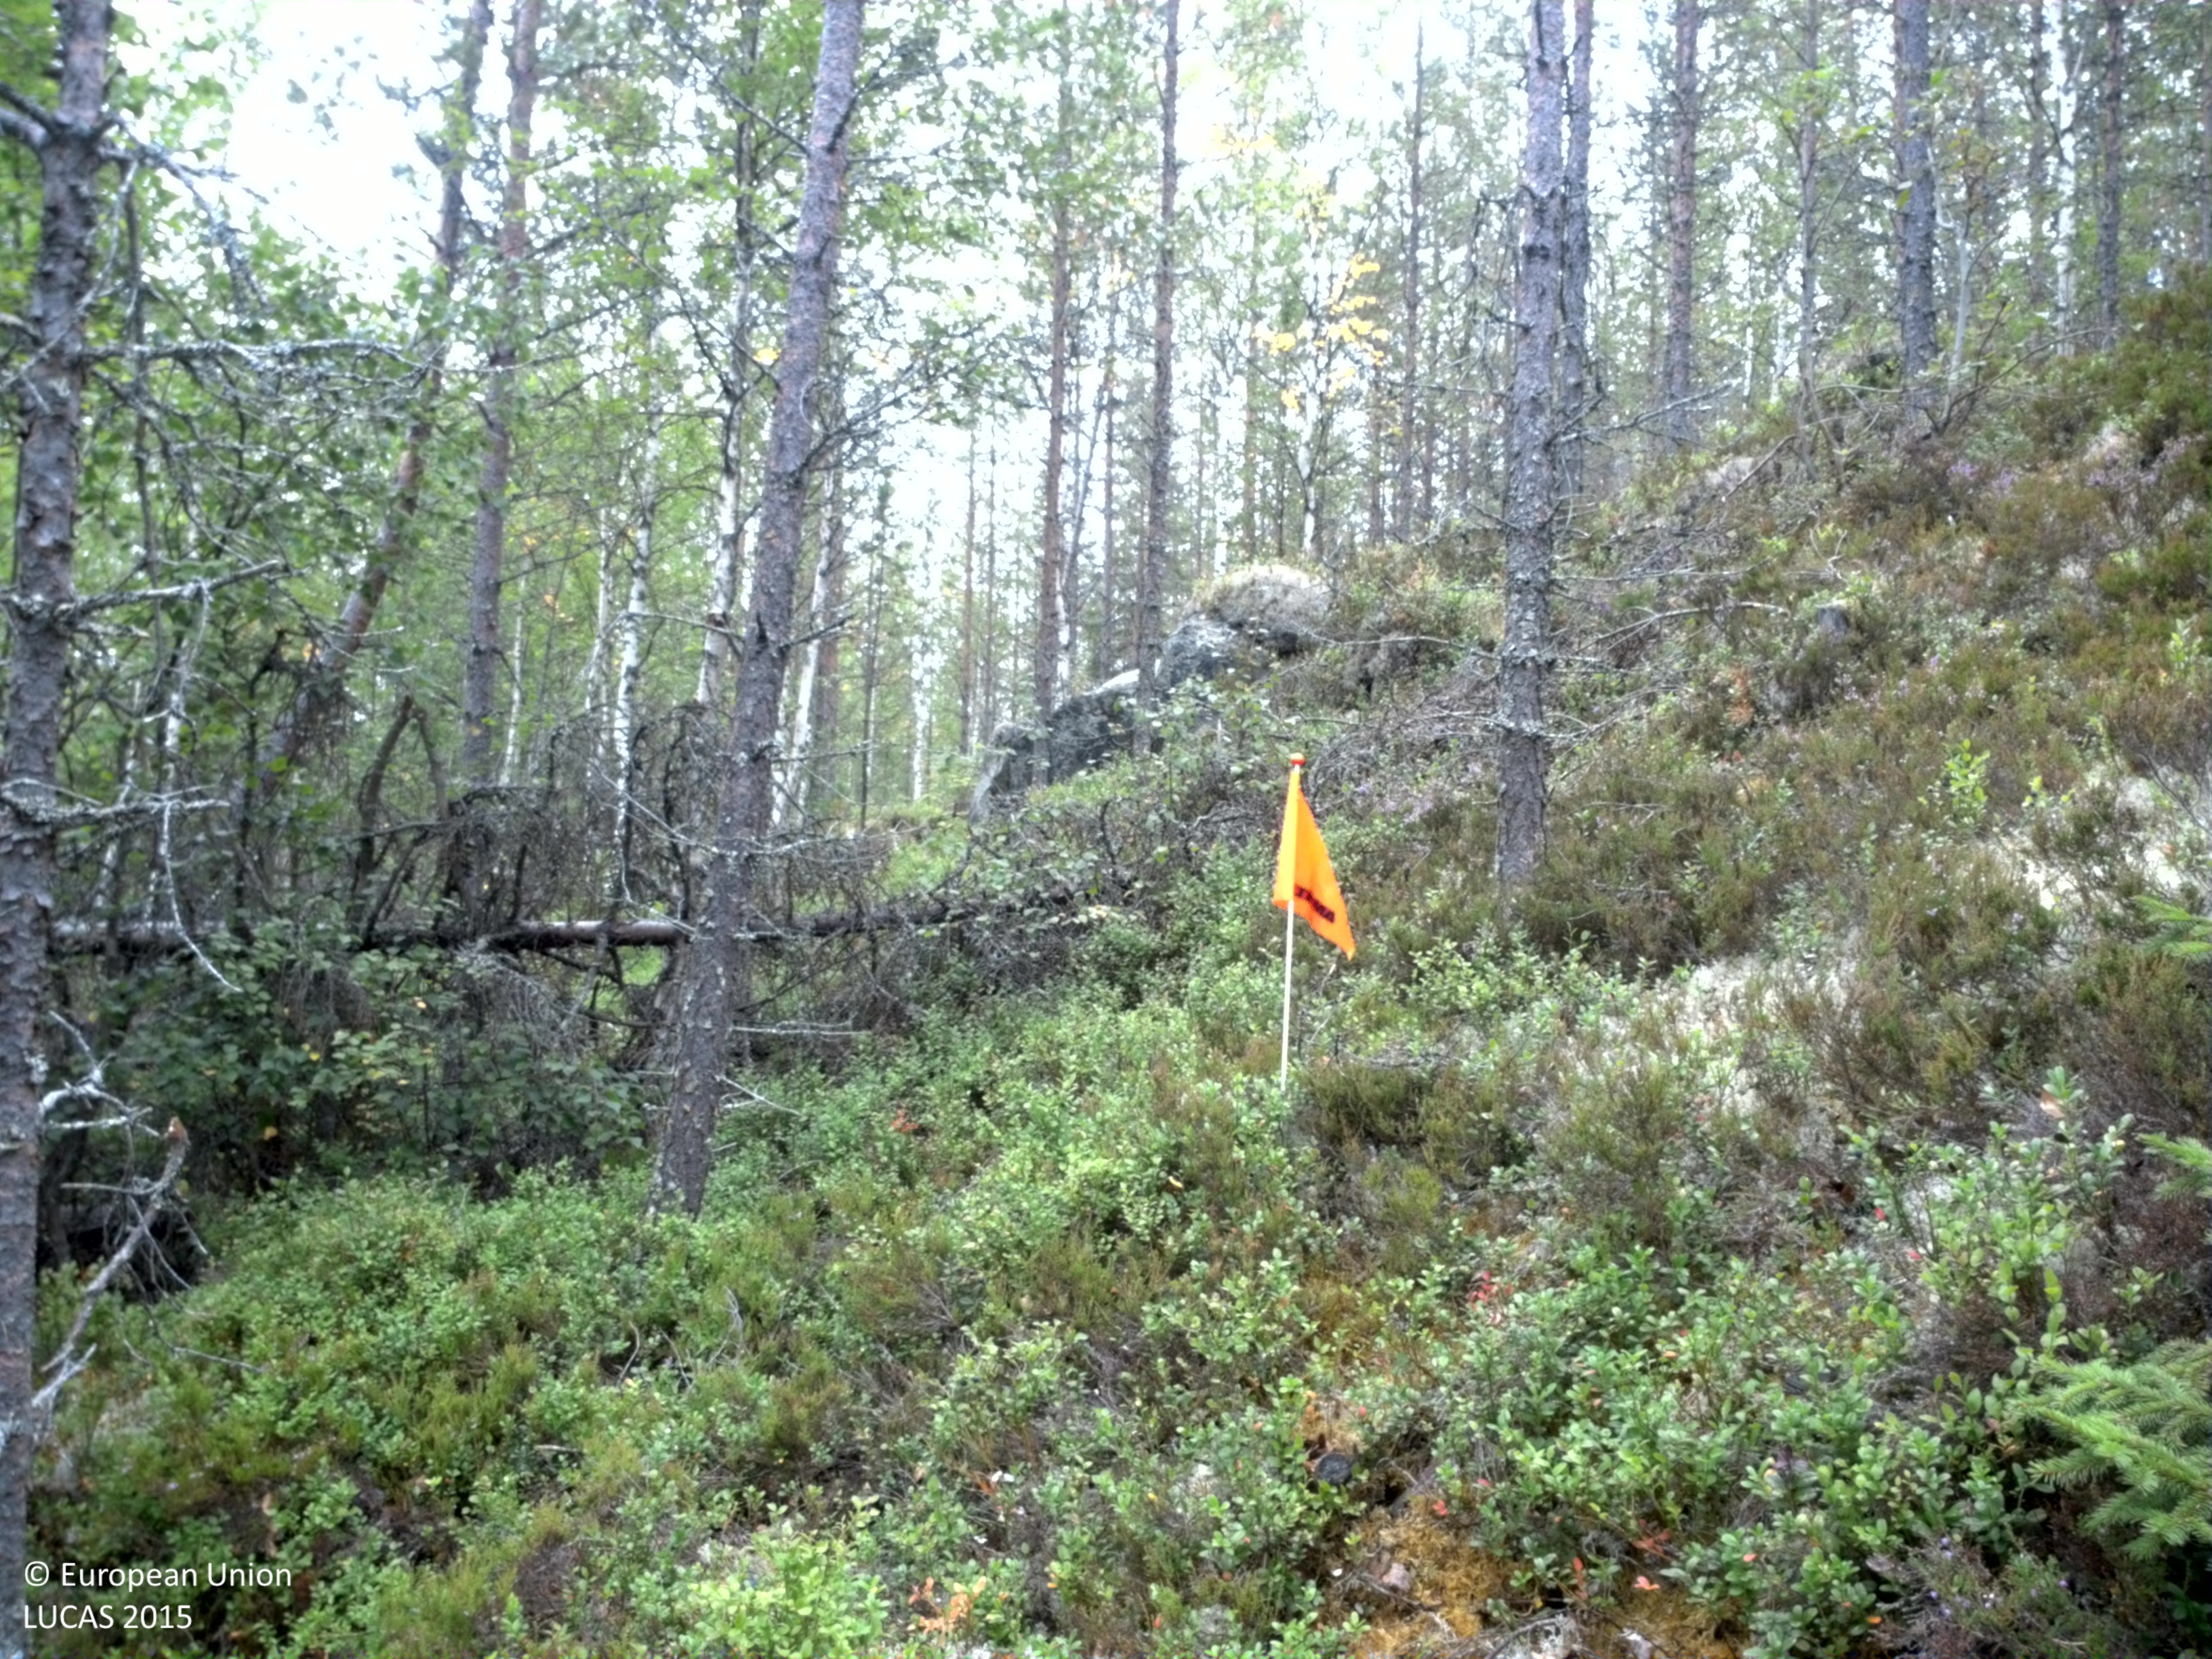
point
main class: Woodland
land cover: Pine dominated mixed woodland
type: boreal forest
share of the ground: 50 - 75 %
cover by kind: coniferous forest trees 40 %, broadleaved forest trees 20 %, shrubs 20 %, lichens and mosses 20 %
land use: Forestry
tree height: > 5 m
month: August
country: SE
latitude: 61.7166
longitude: 14.9969
